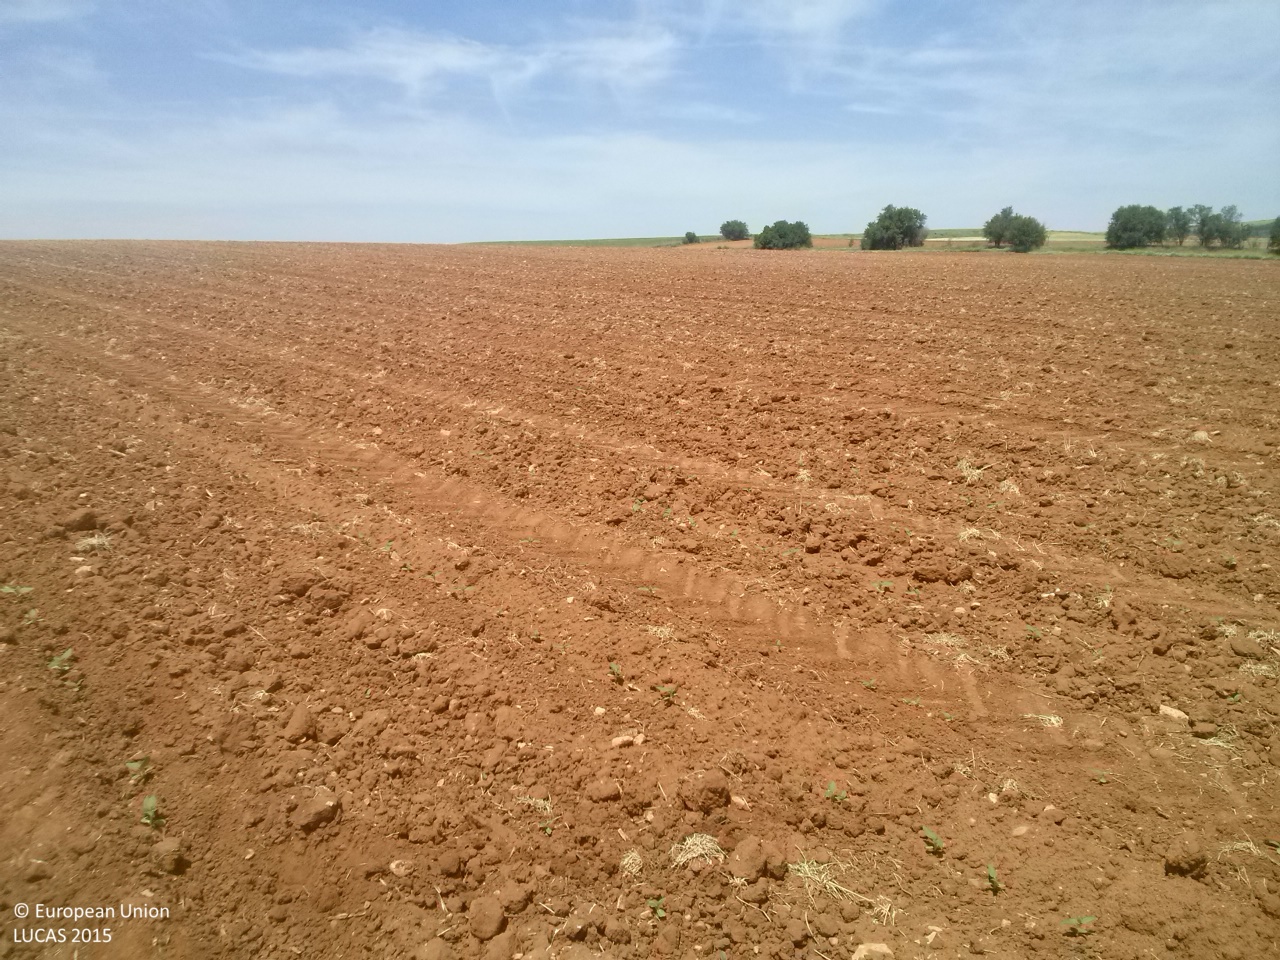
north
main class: Cropland
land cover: Sunflower
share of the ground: < 10 %
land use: Agriculture (excluding fallow land and kitchen gardens)
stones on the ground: 25 - 50 %
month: May
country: ES
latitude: 39.7580
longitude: -2.4929
